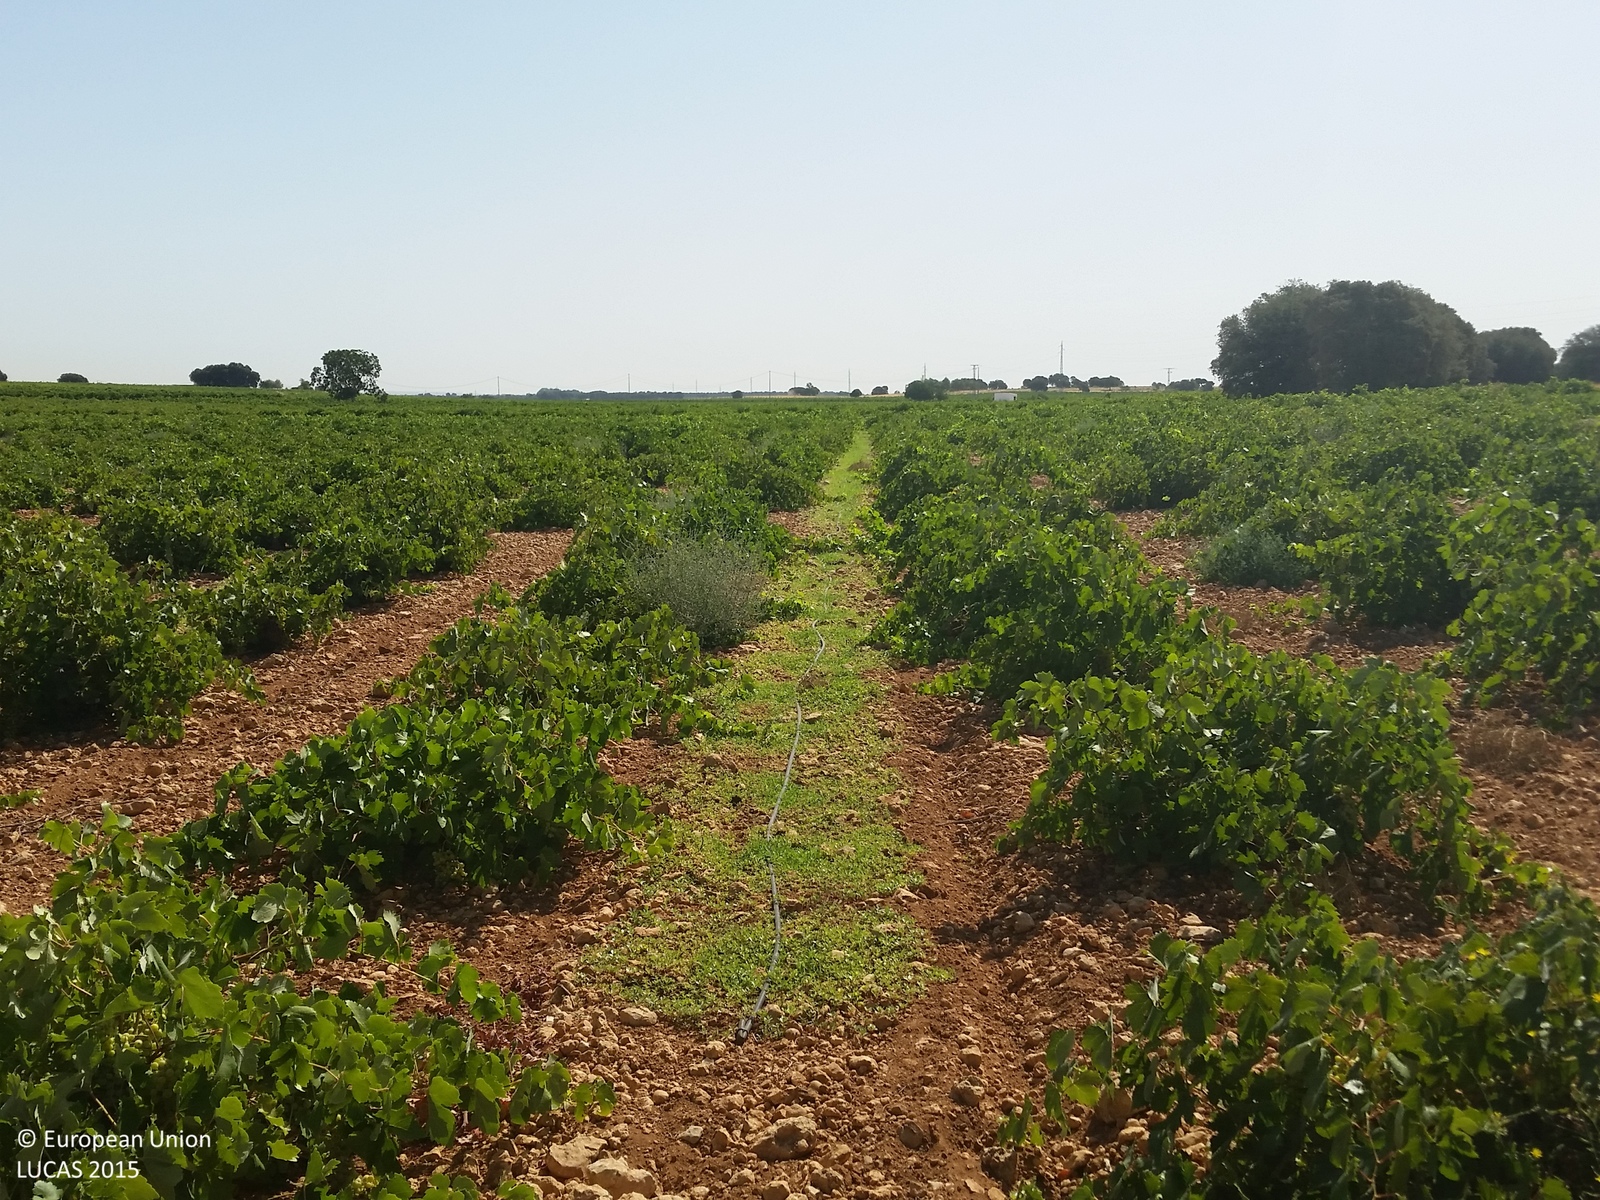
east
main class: Cropland
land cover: Vineyards
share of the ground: 50 - 75 %
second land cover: Spontaneously vegetated surfaces
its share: 50 - 75 %
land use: Agriculture (excluding fallow land and kitchen gardens)
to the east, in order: Vineyards; Spontaneously vegetated surfaces
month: July
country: ES
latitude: 39.3090
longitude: -2.5702
